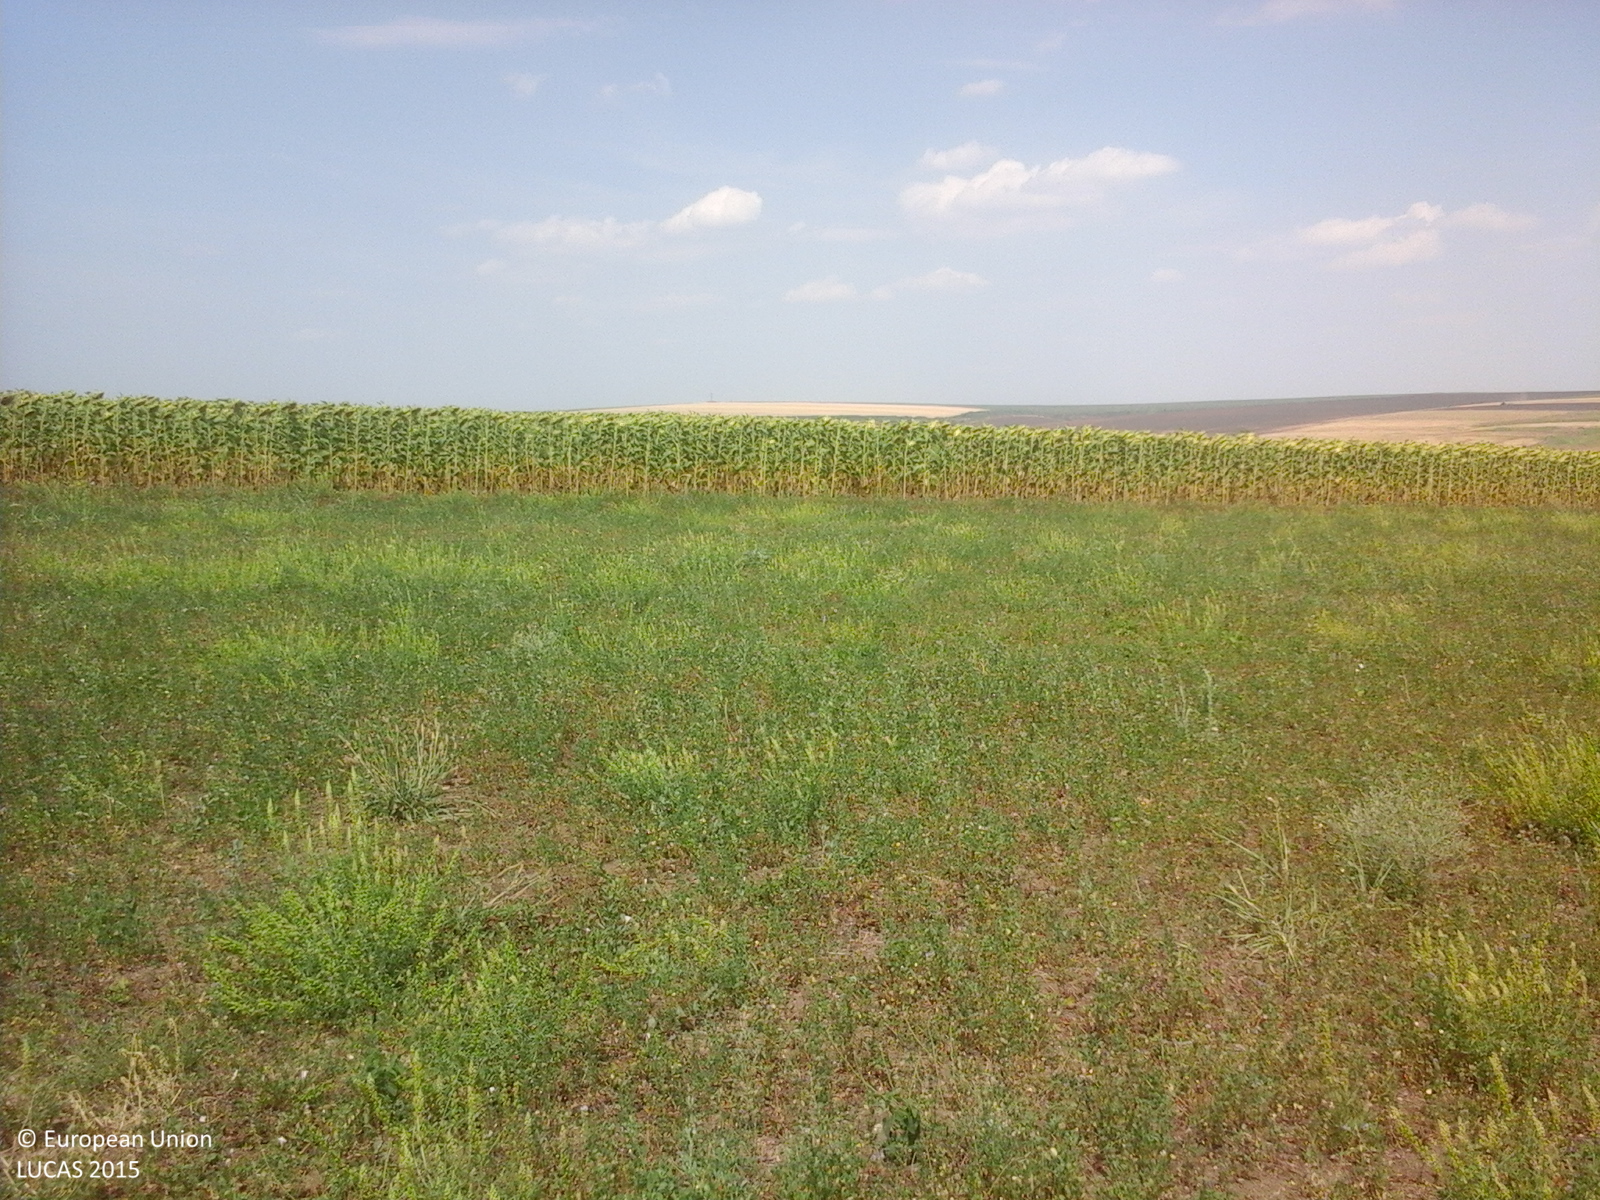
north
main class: Cropland
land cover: Lucerne
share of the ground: > 75 %
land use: Agriculture (excluding fallow land and kitchen gardens)
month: July
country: RO
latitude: 46.2399
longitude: 28.0350
